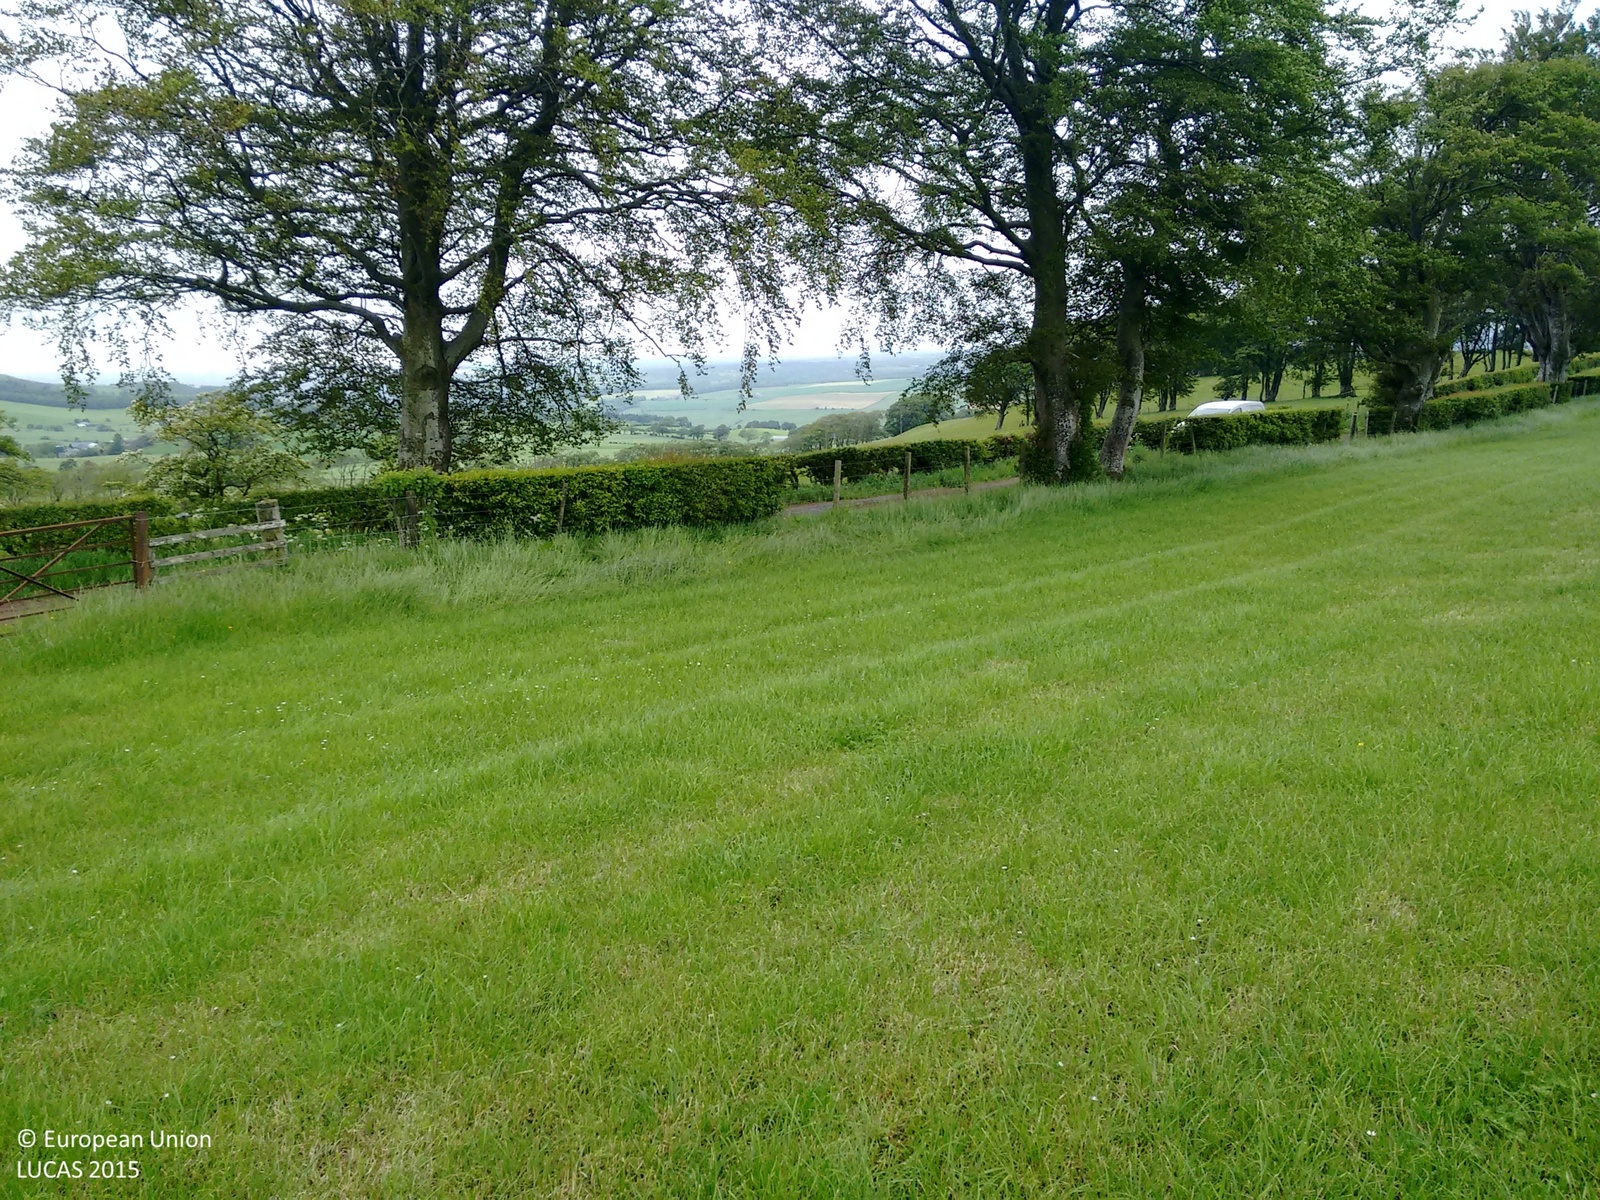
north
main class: Grassland
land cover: Grassland without tree/shrub cover
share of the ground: > 75 %
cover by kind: herbaceous plants 100 %
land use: Agriculture (excluding fallow land and kitchen gardens)
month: June
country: GB
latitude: 55.6529
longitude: -3.8321
